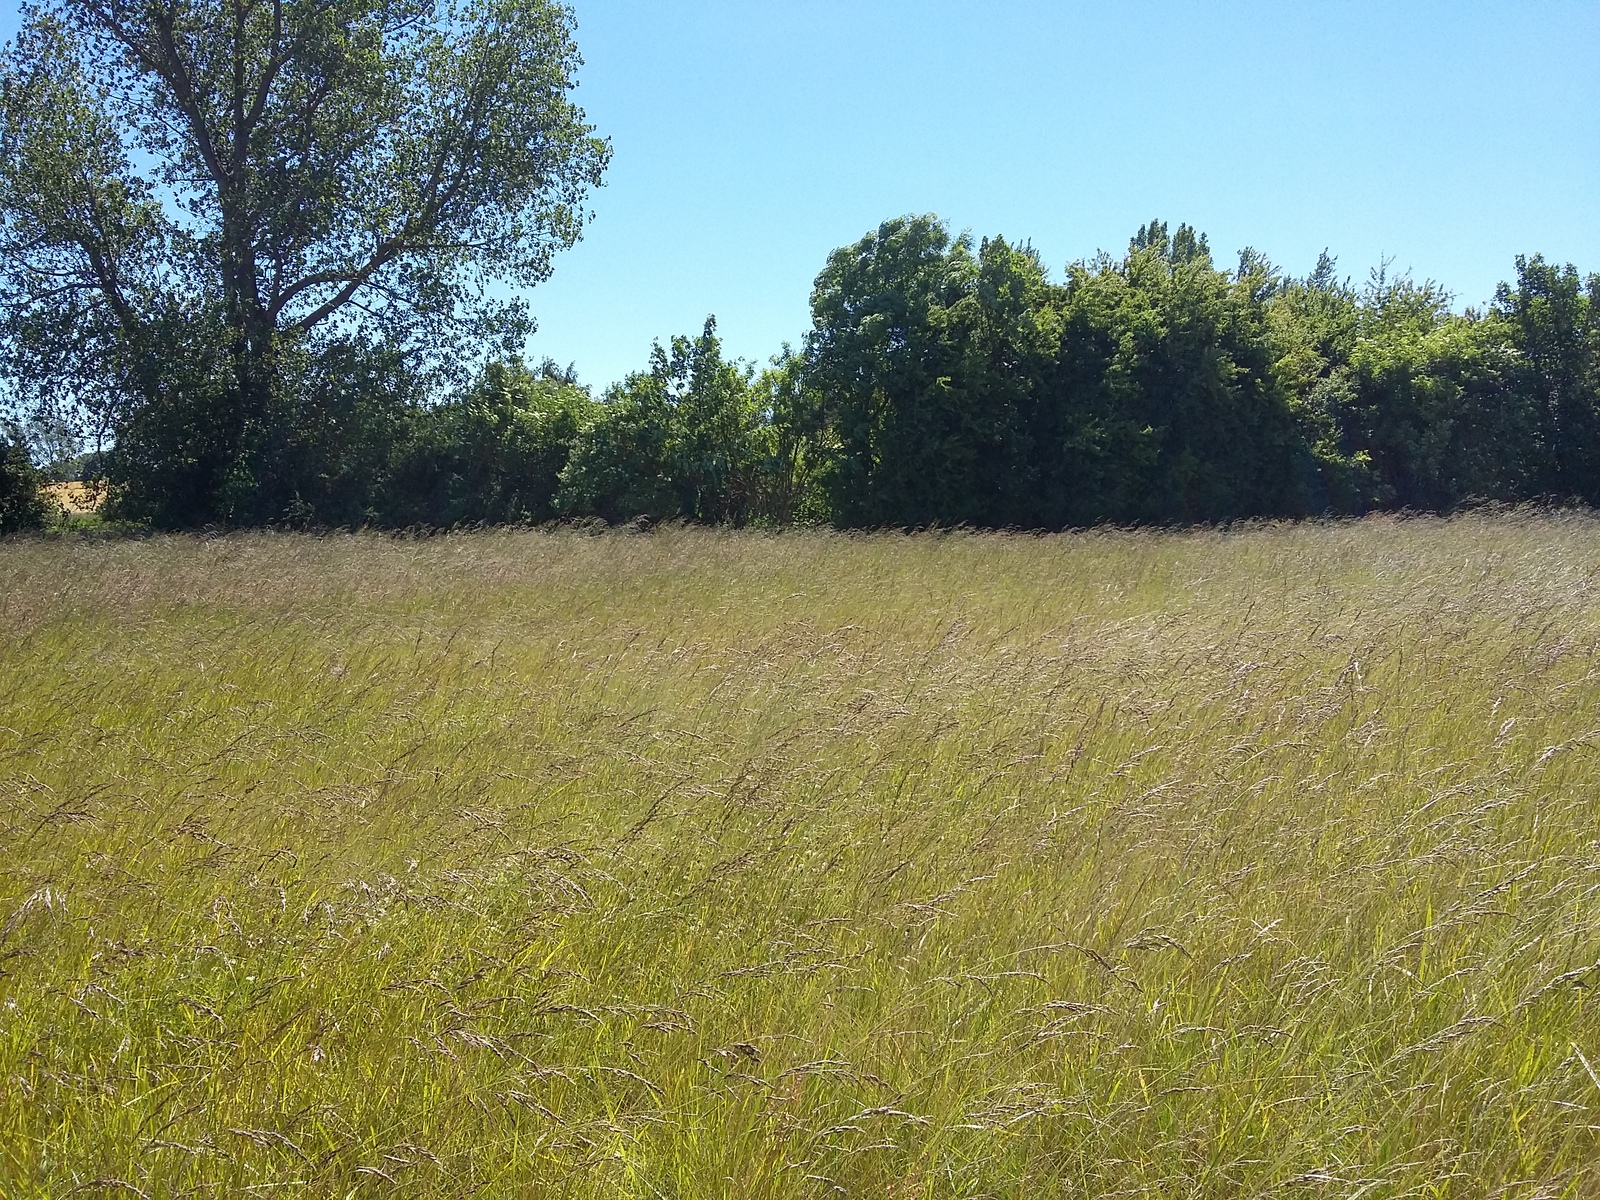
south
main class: Grassland
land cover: Grassland without tree/shrub cover
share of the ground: > 75 %
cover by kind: herbaceous plants 100 %
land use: Agriculture (excluding fallow land and kitchen gardens)
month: July
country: DK
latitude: 55.0930
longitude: 12.0199
